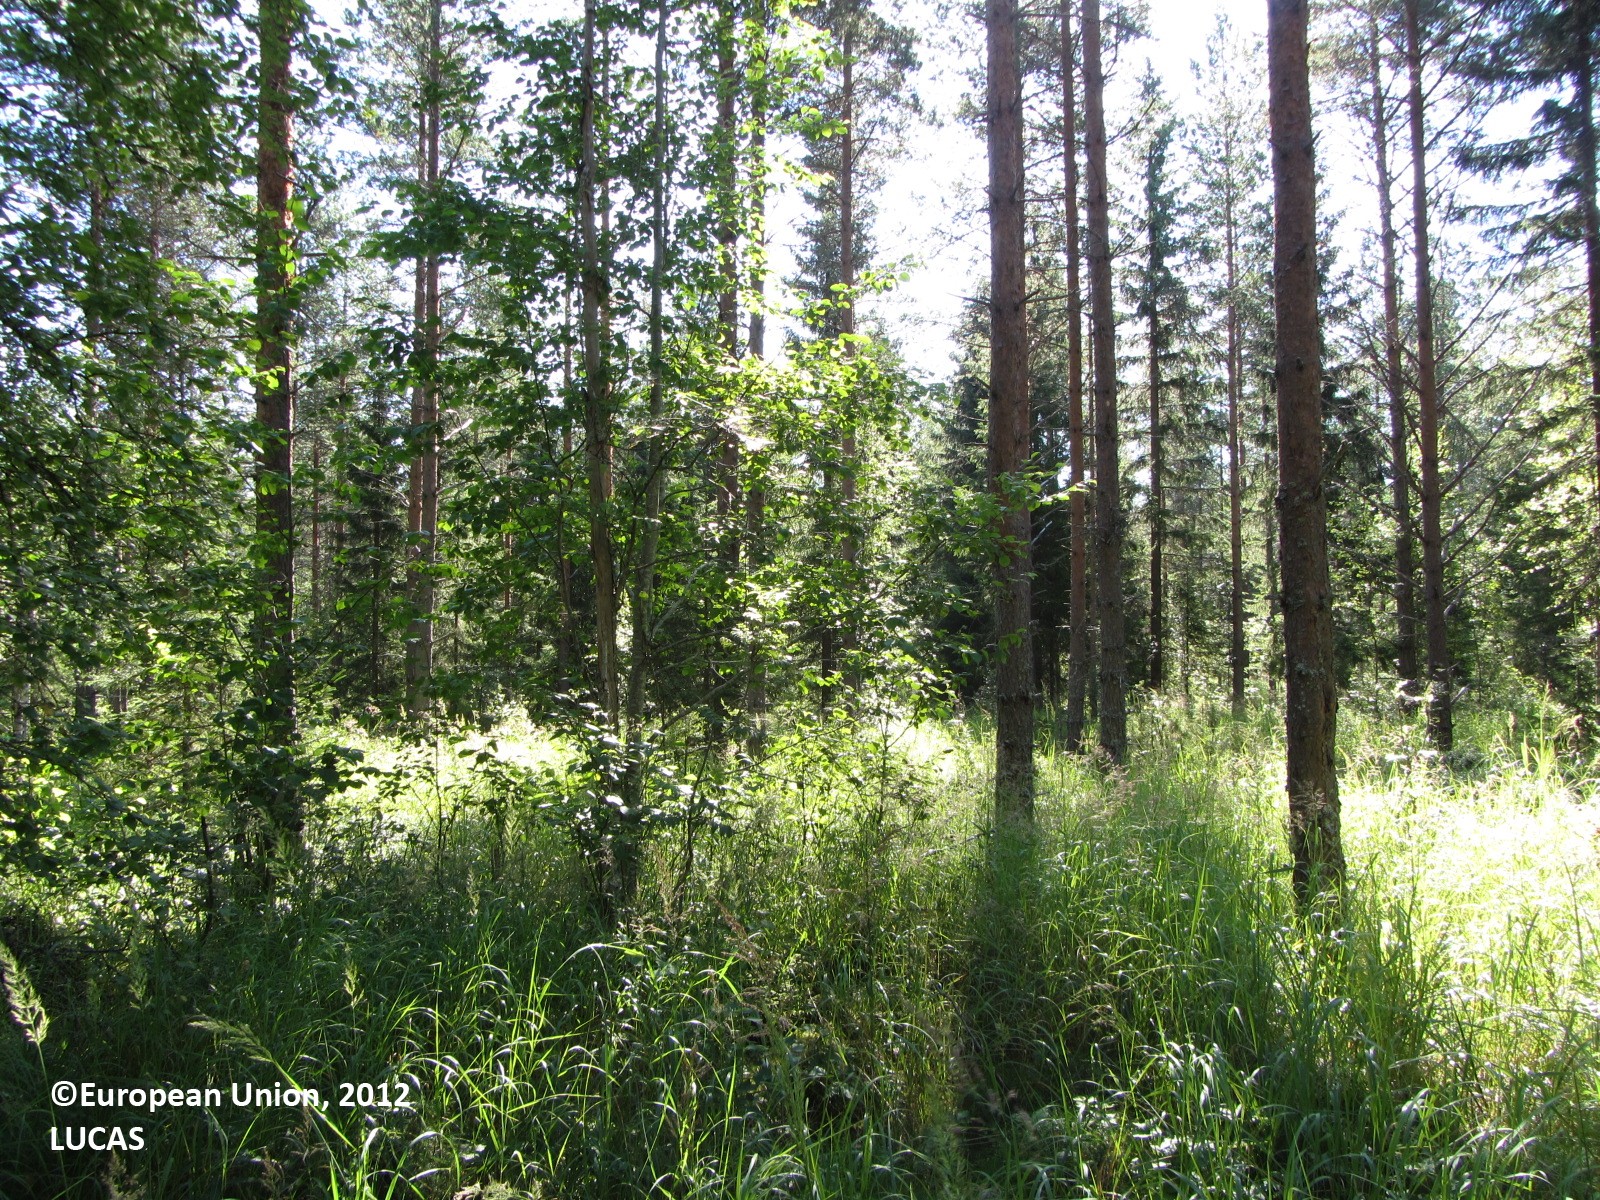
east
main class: Woodland
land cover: Pine dominated coniferous woodland
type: boreal forest
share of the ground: 50 - 75 %
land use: Forestry
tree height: > 5 m
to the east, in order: Pine dominated coniferous woodland; Grassland with sparse tree/shrub cover; Broadleaved woodland; Spruce dominated coniferous woodland; Ditches and canals; Spruce dominated coniferous woodland; Spruce dominated mixed woodland; Ditches and canals; Pine dominated mixed woodland; Ditches and canals; Pine dominated mixed woodland
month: July
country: FI
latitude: 63.6370
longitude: 24.6754
